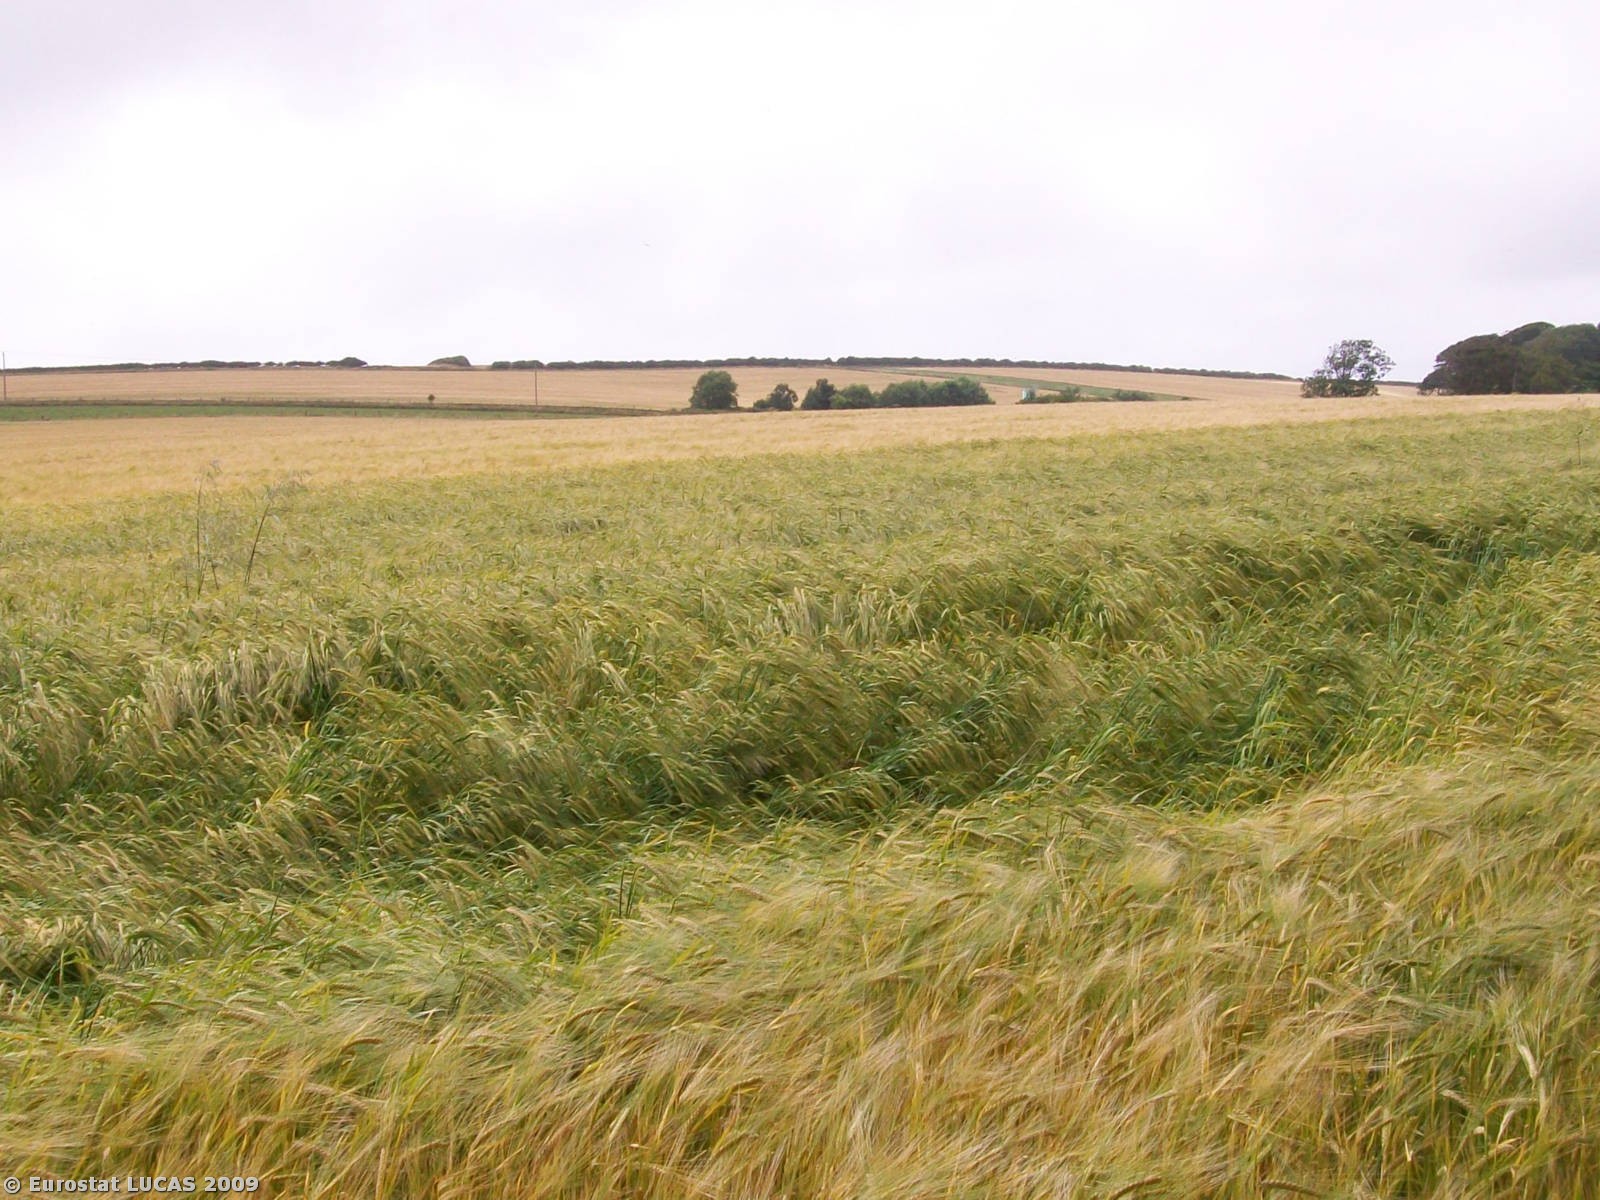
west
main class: Cropland
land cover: Barley
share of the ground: > 75 %
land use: Agriculture (excluding fallow land and kitchen gardens)
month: July
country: GB
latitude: 50.7048
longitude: -2.5703
